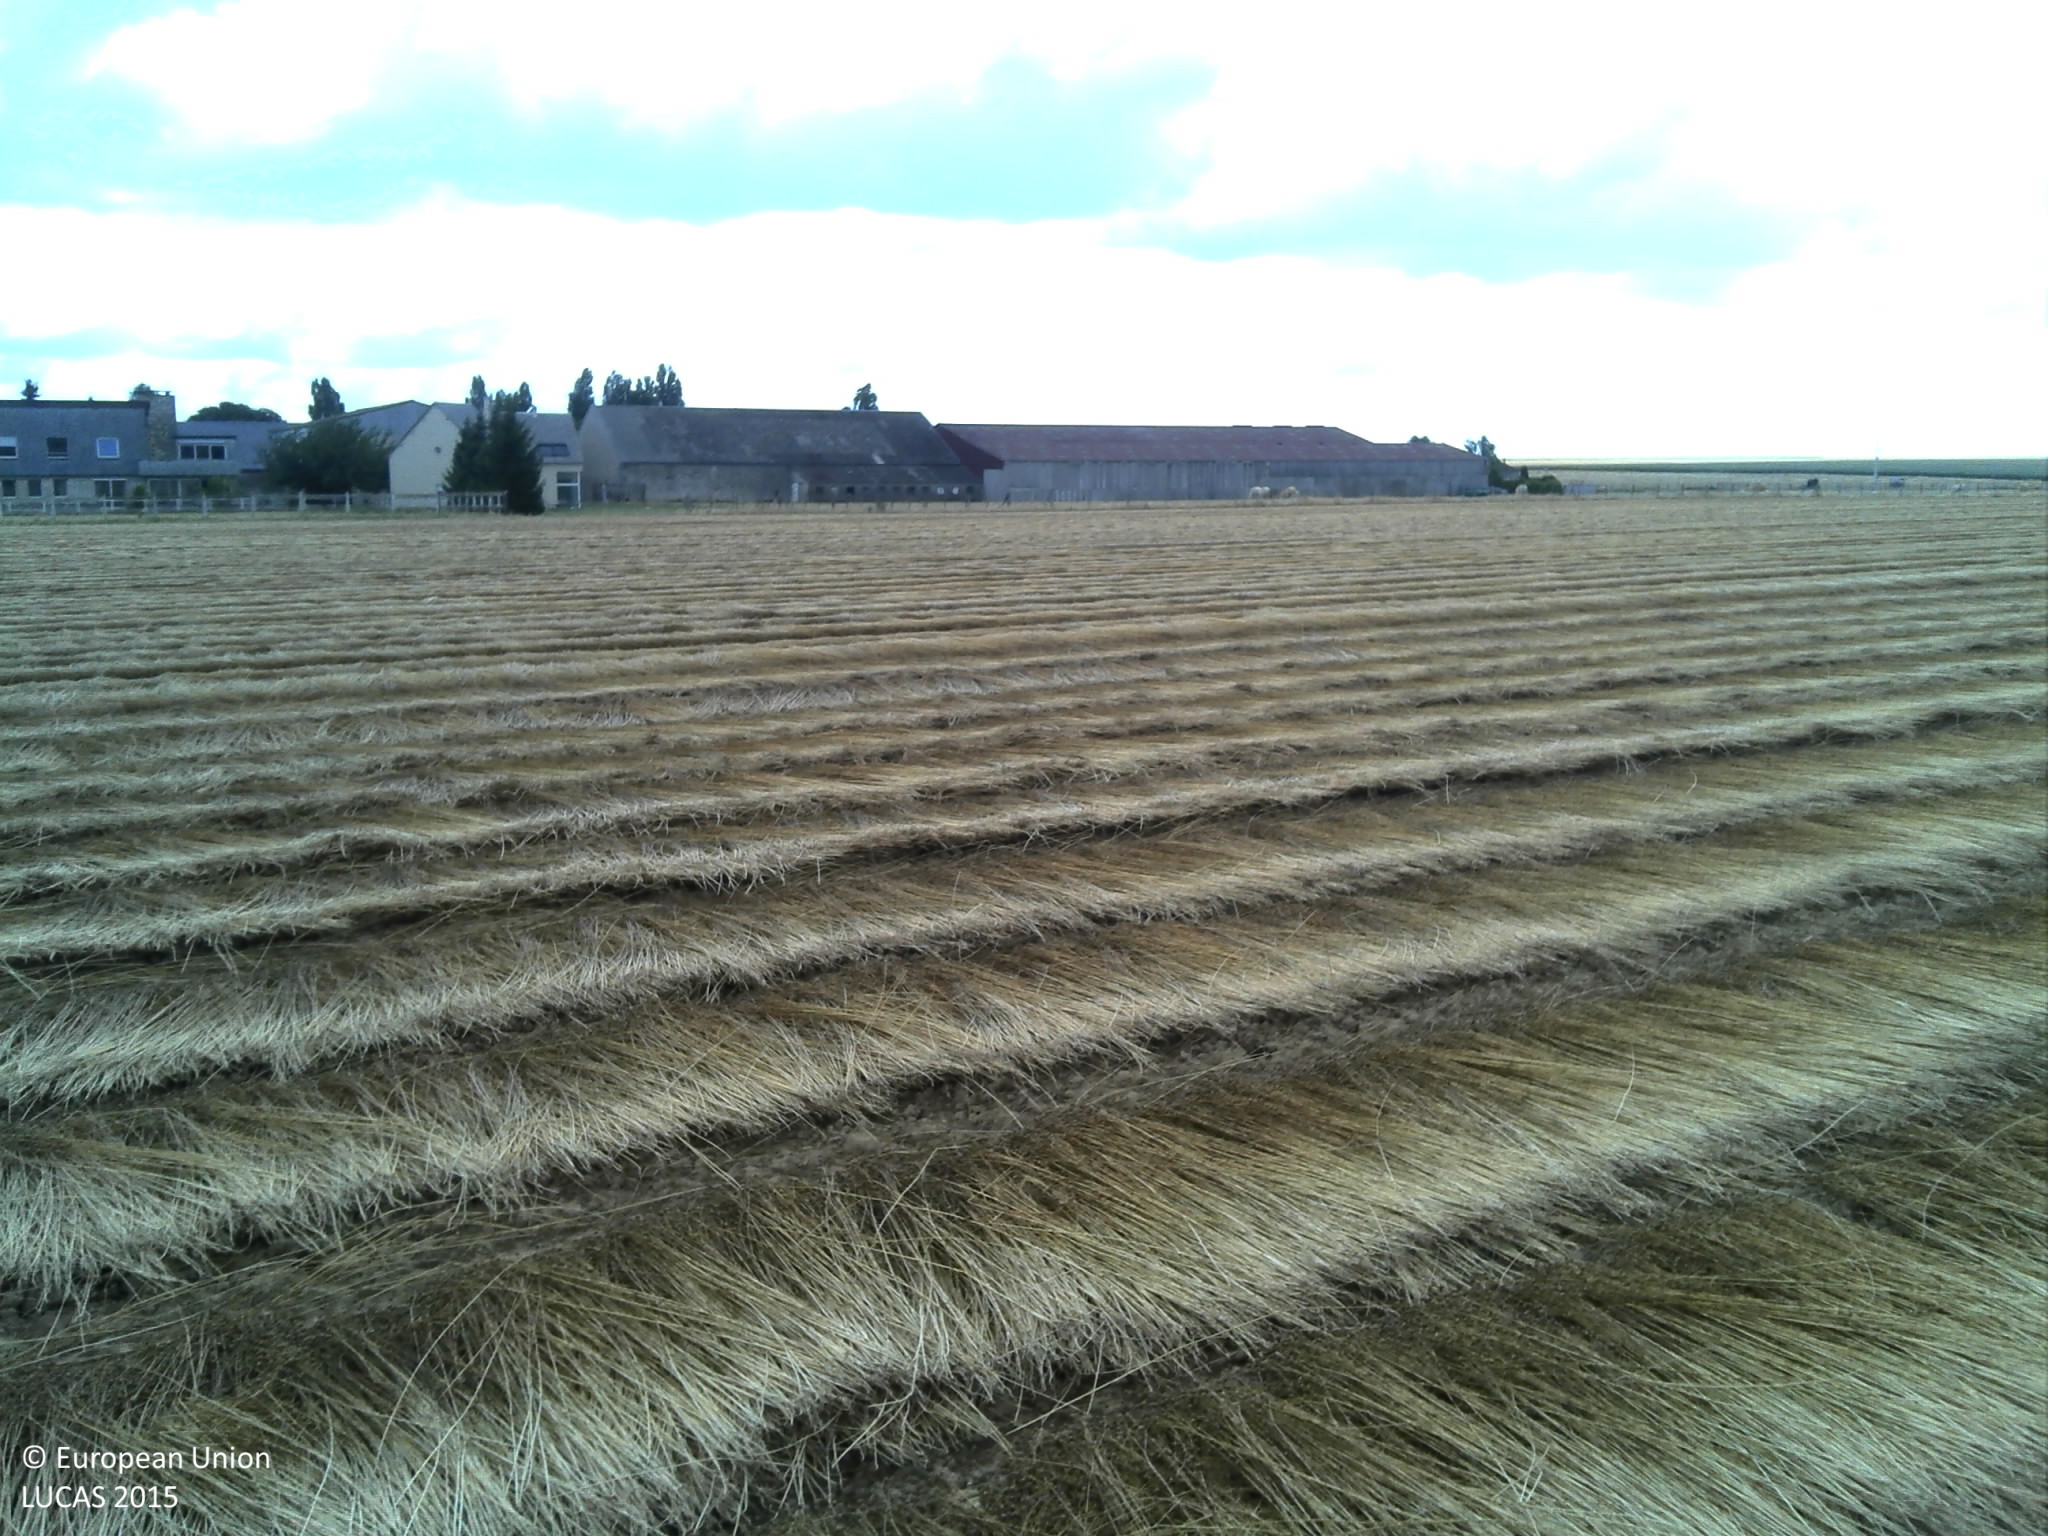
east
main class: Cropland
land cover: Other fibre and oleaginous crops
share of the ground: > 75 %
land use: Agriculture (excluding fallow land and kitchen gardens)
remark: Harvested field
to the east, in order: Other fibre and oleaginous crops; Fences; Grassland without tree/shrub cover; Artificial constructions in urban areas
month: July
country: FR
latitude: 48.8774
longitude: 1.8170
